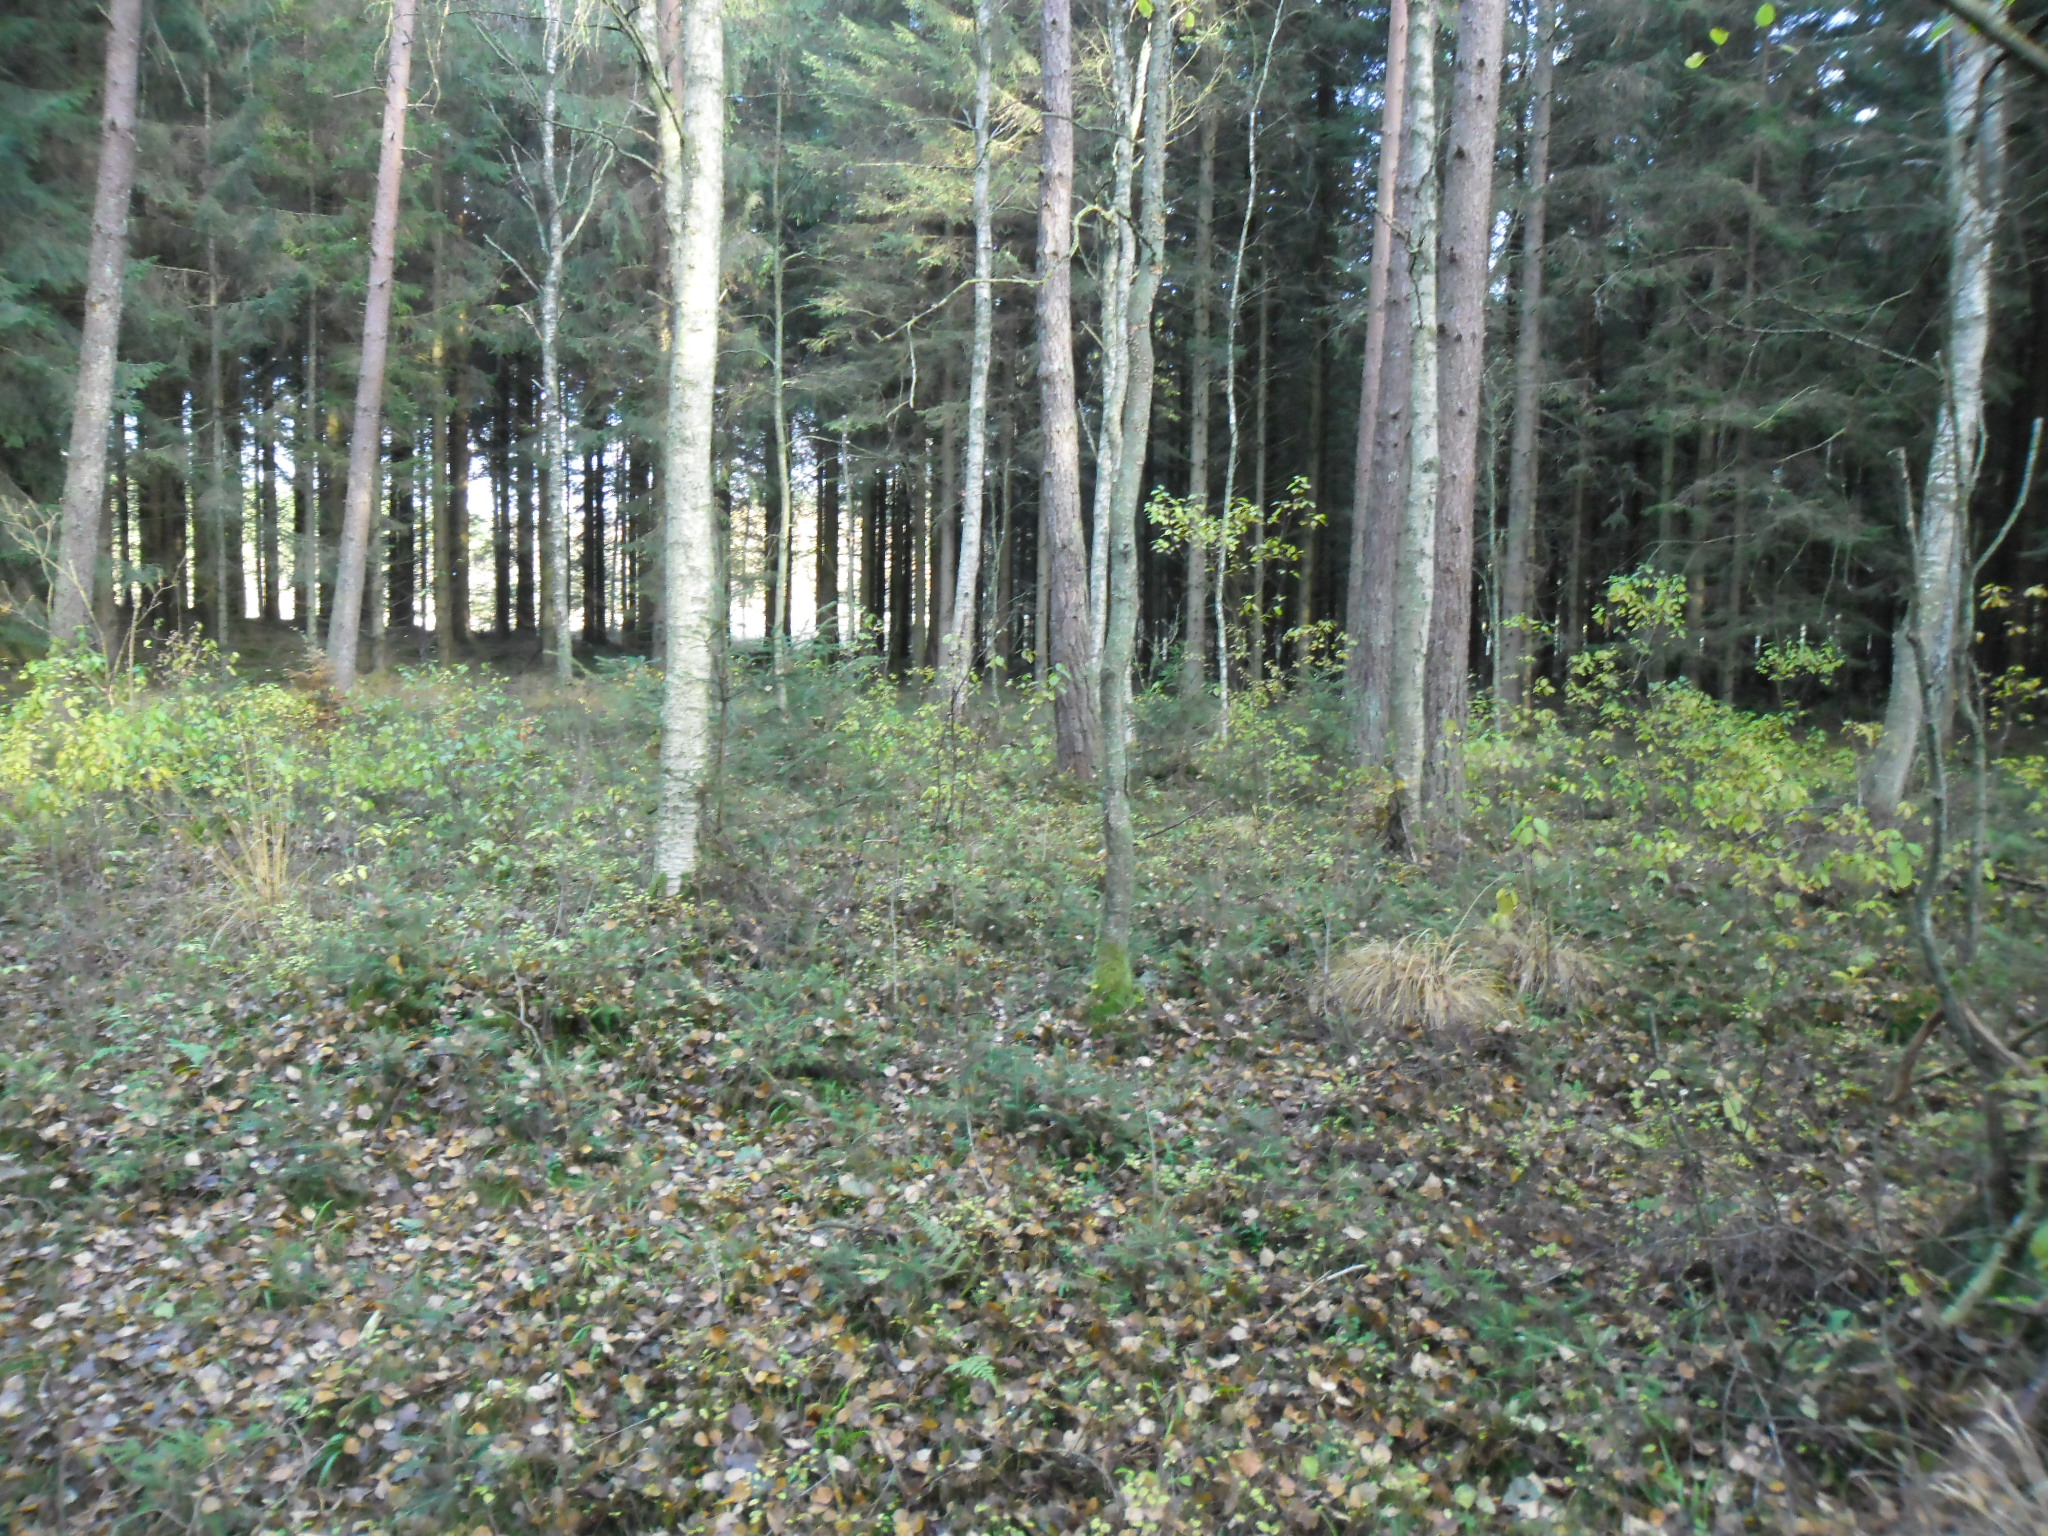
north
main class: Woodland
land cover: Pine dominated mixed woodland
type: boreal forest
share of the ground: > 75 %
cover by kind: coniferous forest trees 50 %, broadleaved forest trees 25 %, herbaceous plants 25 %
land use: Forestry
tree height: > 5 m
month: October
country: SE
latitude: 56.3103
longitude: 13.1817
